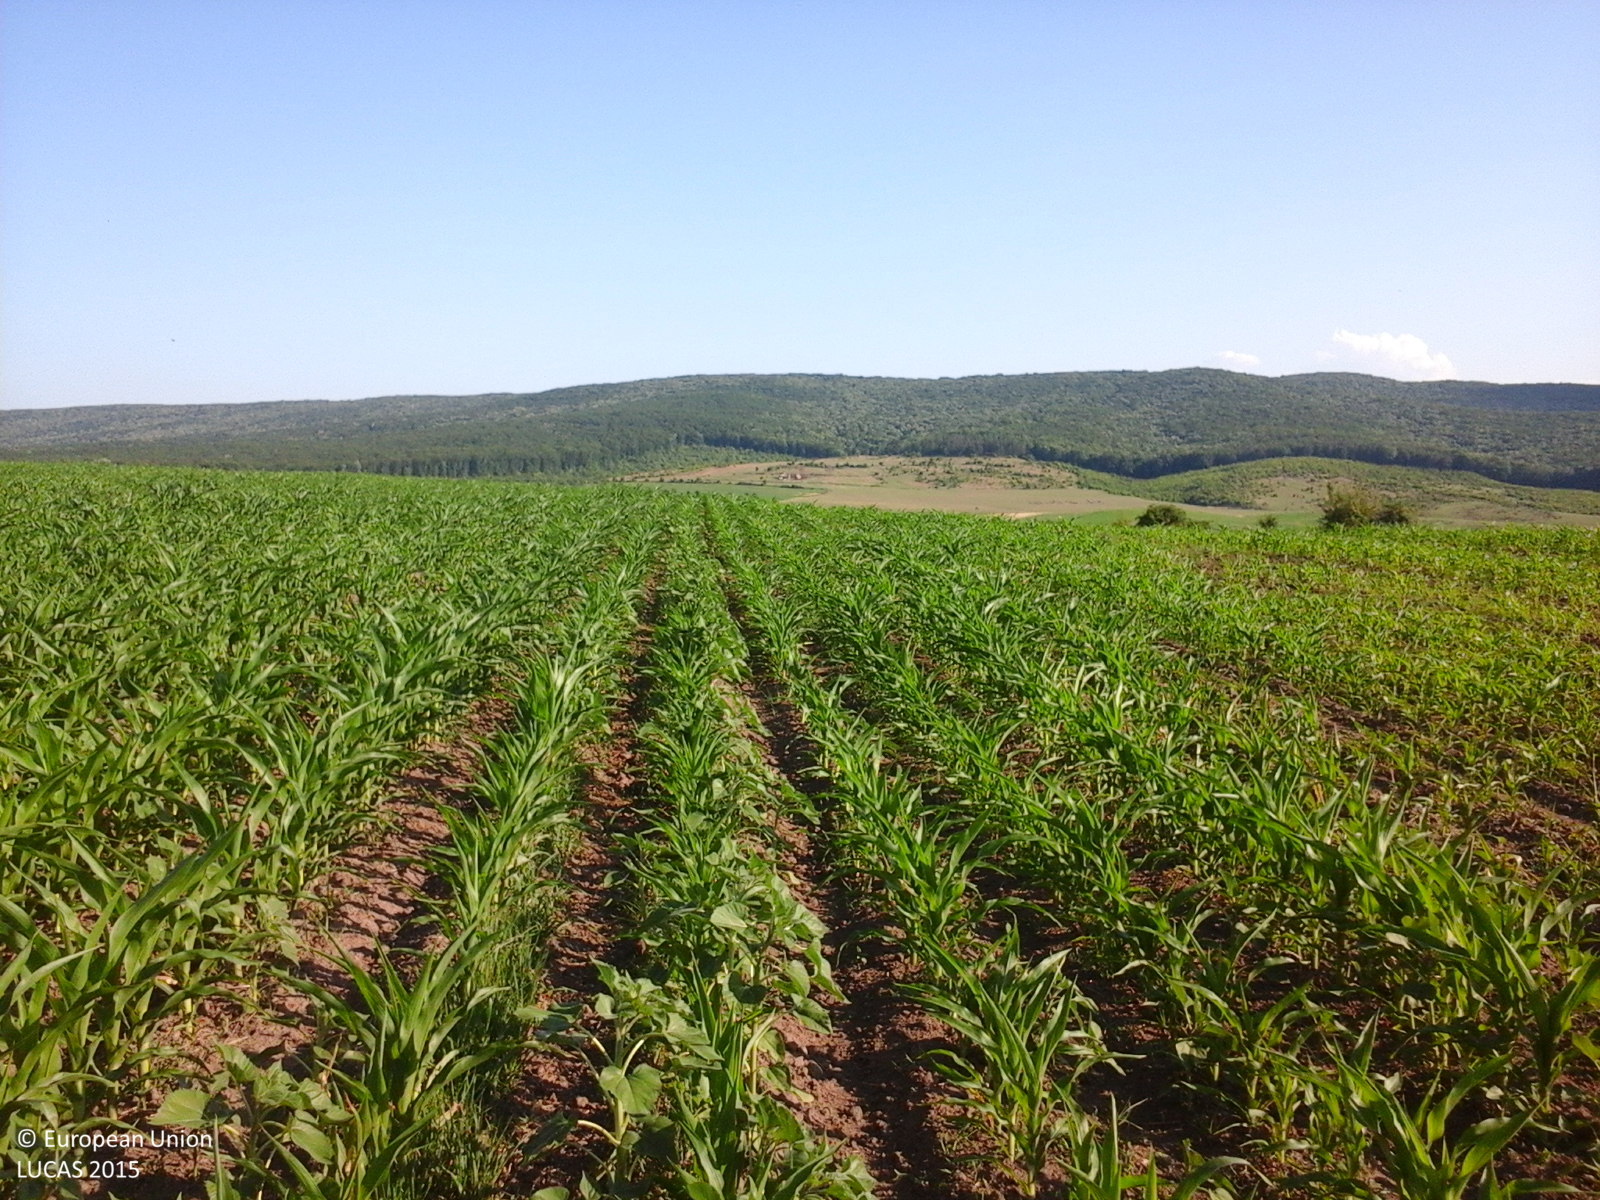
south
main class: Cropland
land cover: Maize
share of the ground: 50 - 75 %
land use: Agriculture (excluding fallow land and kitchen gardens)
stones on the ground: < 10 %
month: June
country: RO
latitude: 47.1162
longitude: 27.3091
